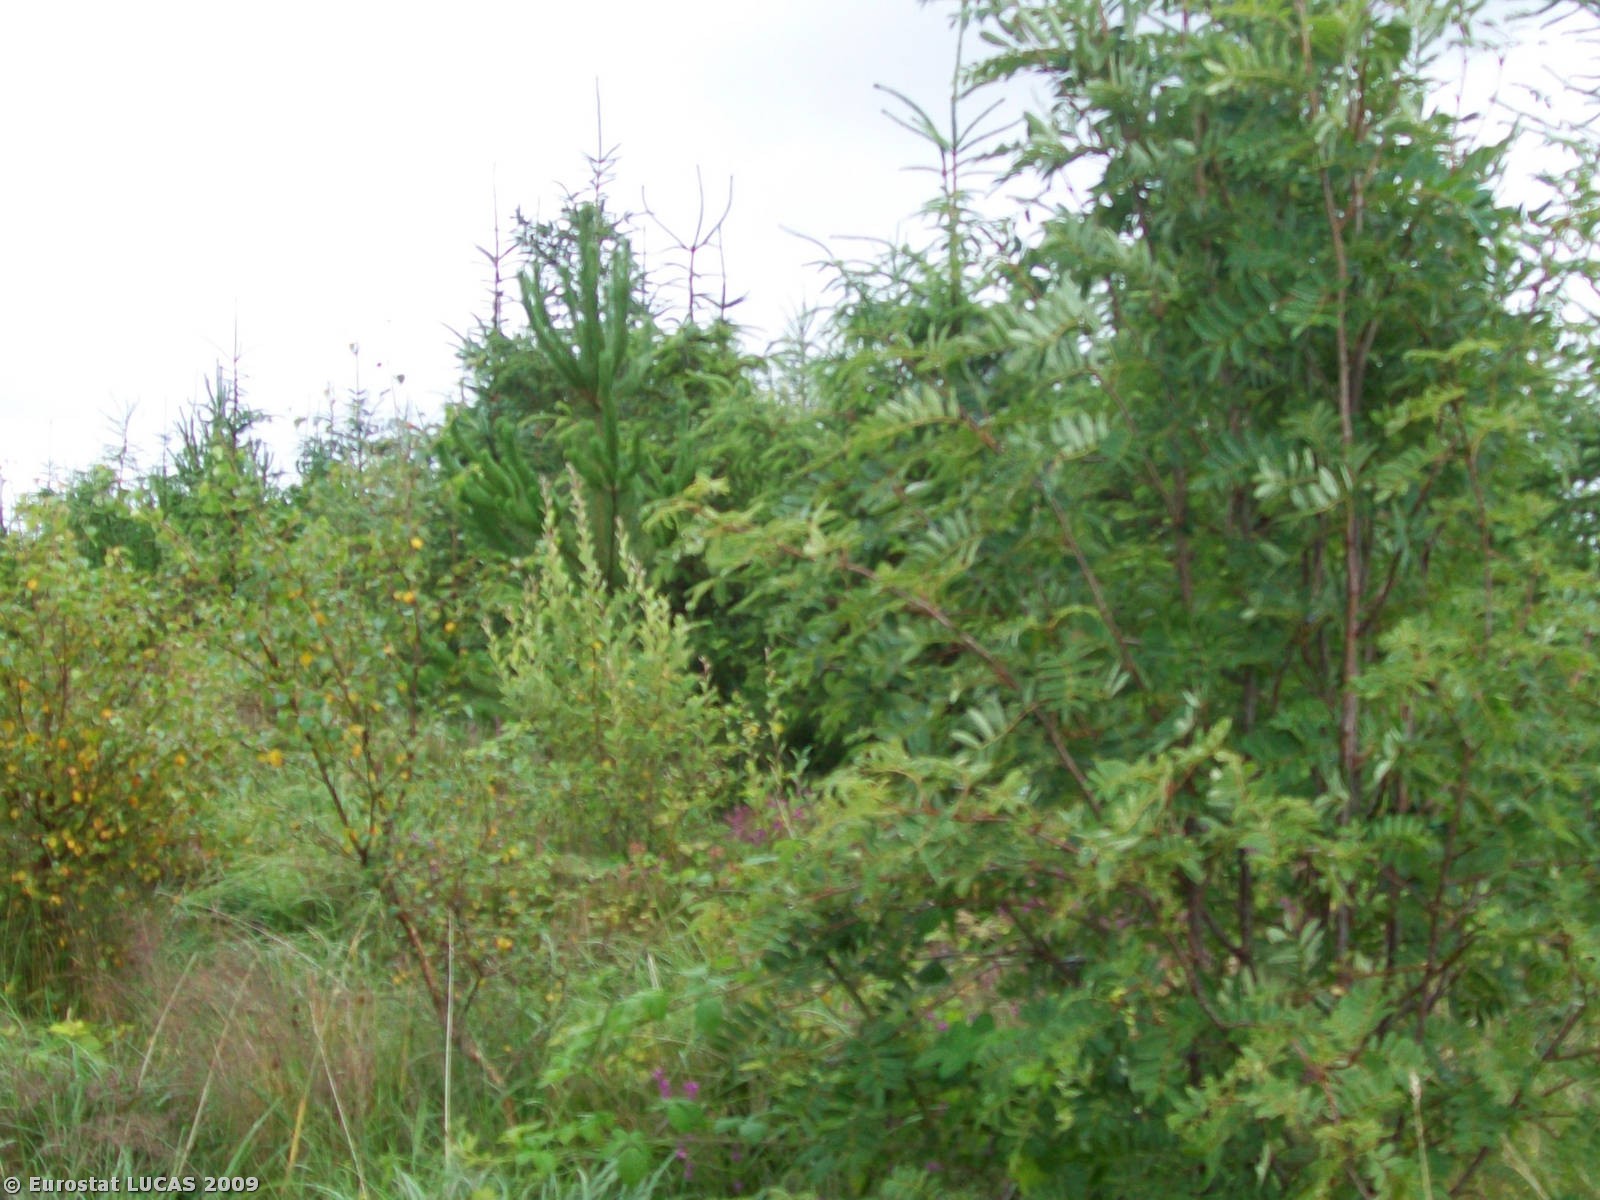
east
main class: Woodland
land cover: Coniferous woodland
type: plantations and self-sown exotic forest
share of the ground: > 75 %
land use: Forestry
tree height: > 5 m
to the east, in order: Coniferous woodland; Grassland without tree/shrub cover
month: July
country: IE
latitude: 53.9580
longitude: -9.0665
